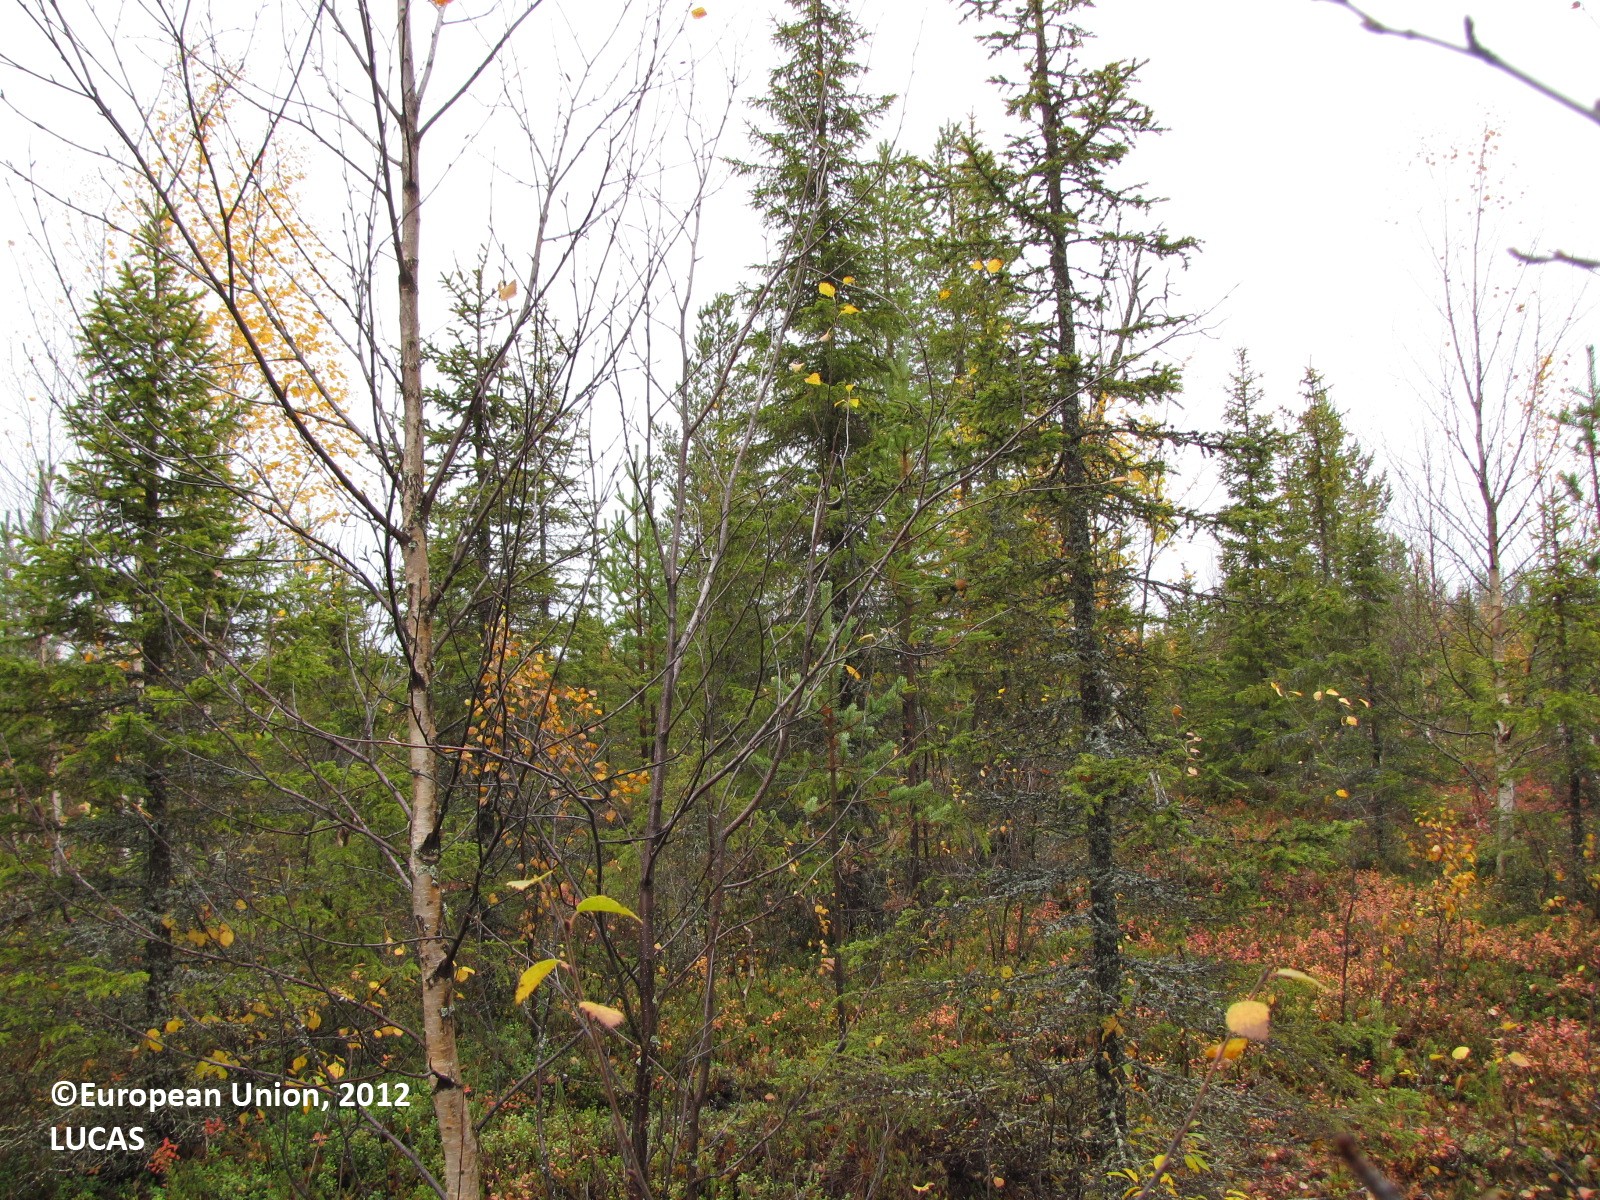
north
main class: Woodland
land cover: Other coniferous woodland
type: boreal forest
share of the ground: 25 - 50 %
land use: Forestry
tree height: > 5 m
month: September
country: FI
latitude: 67.4368
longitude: 25.3916
